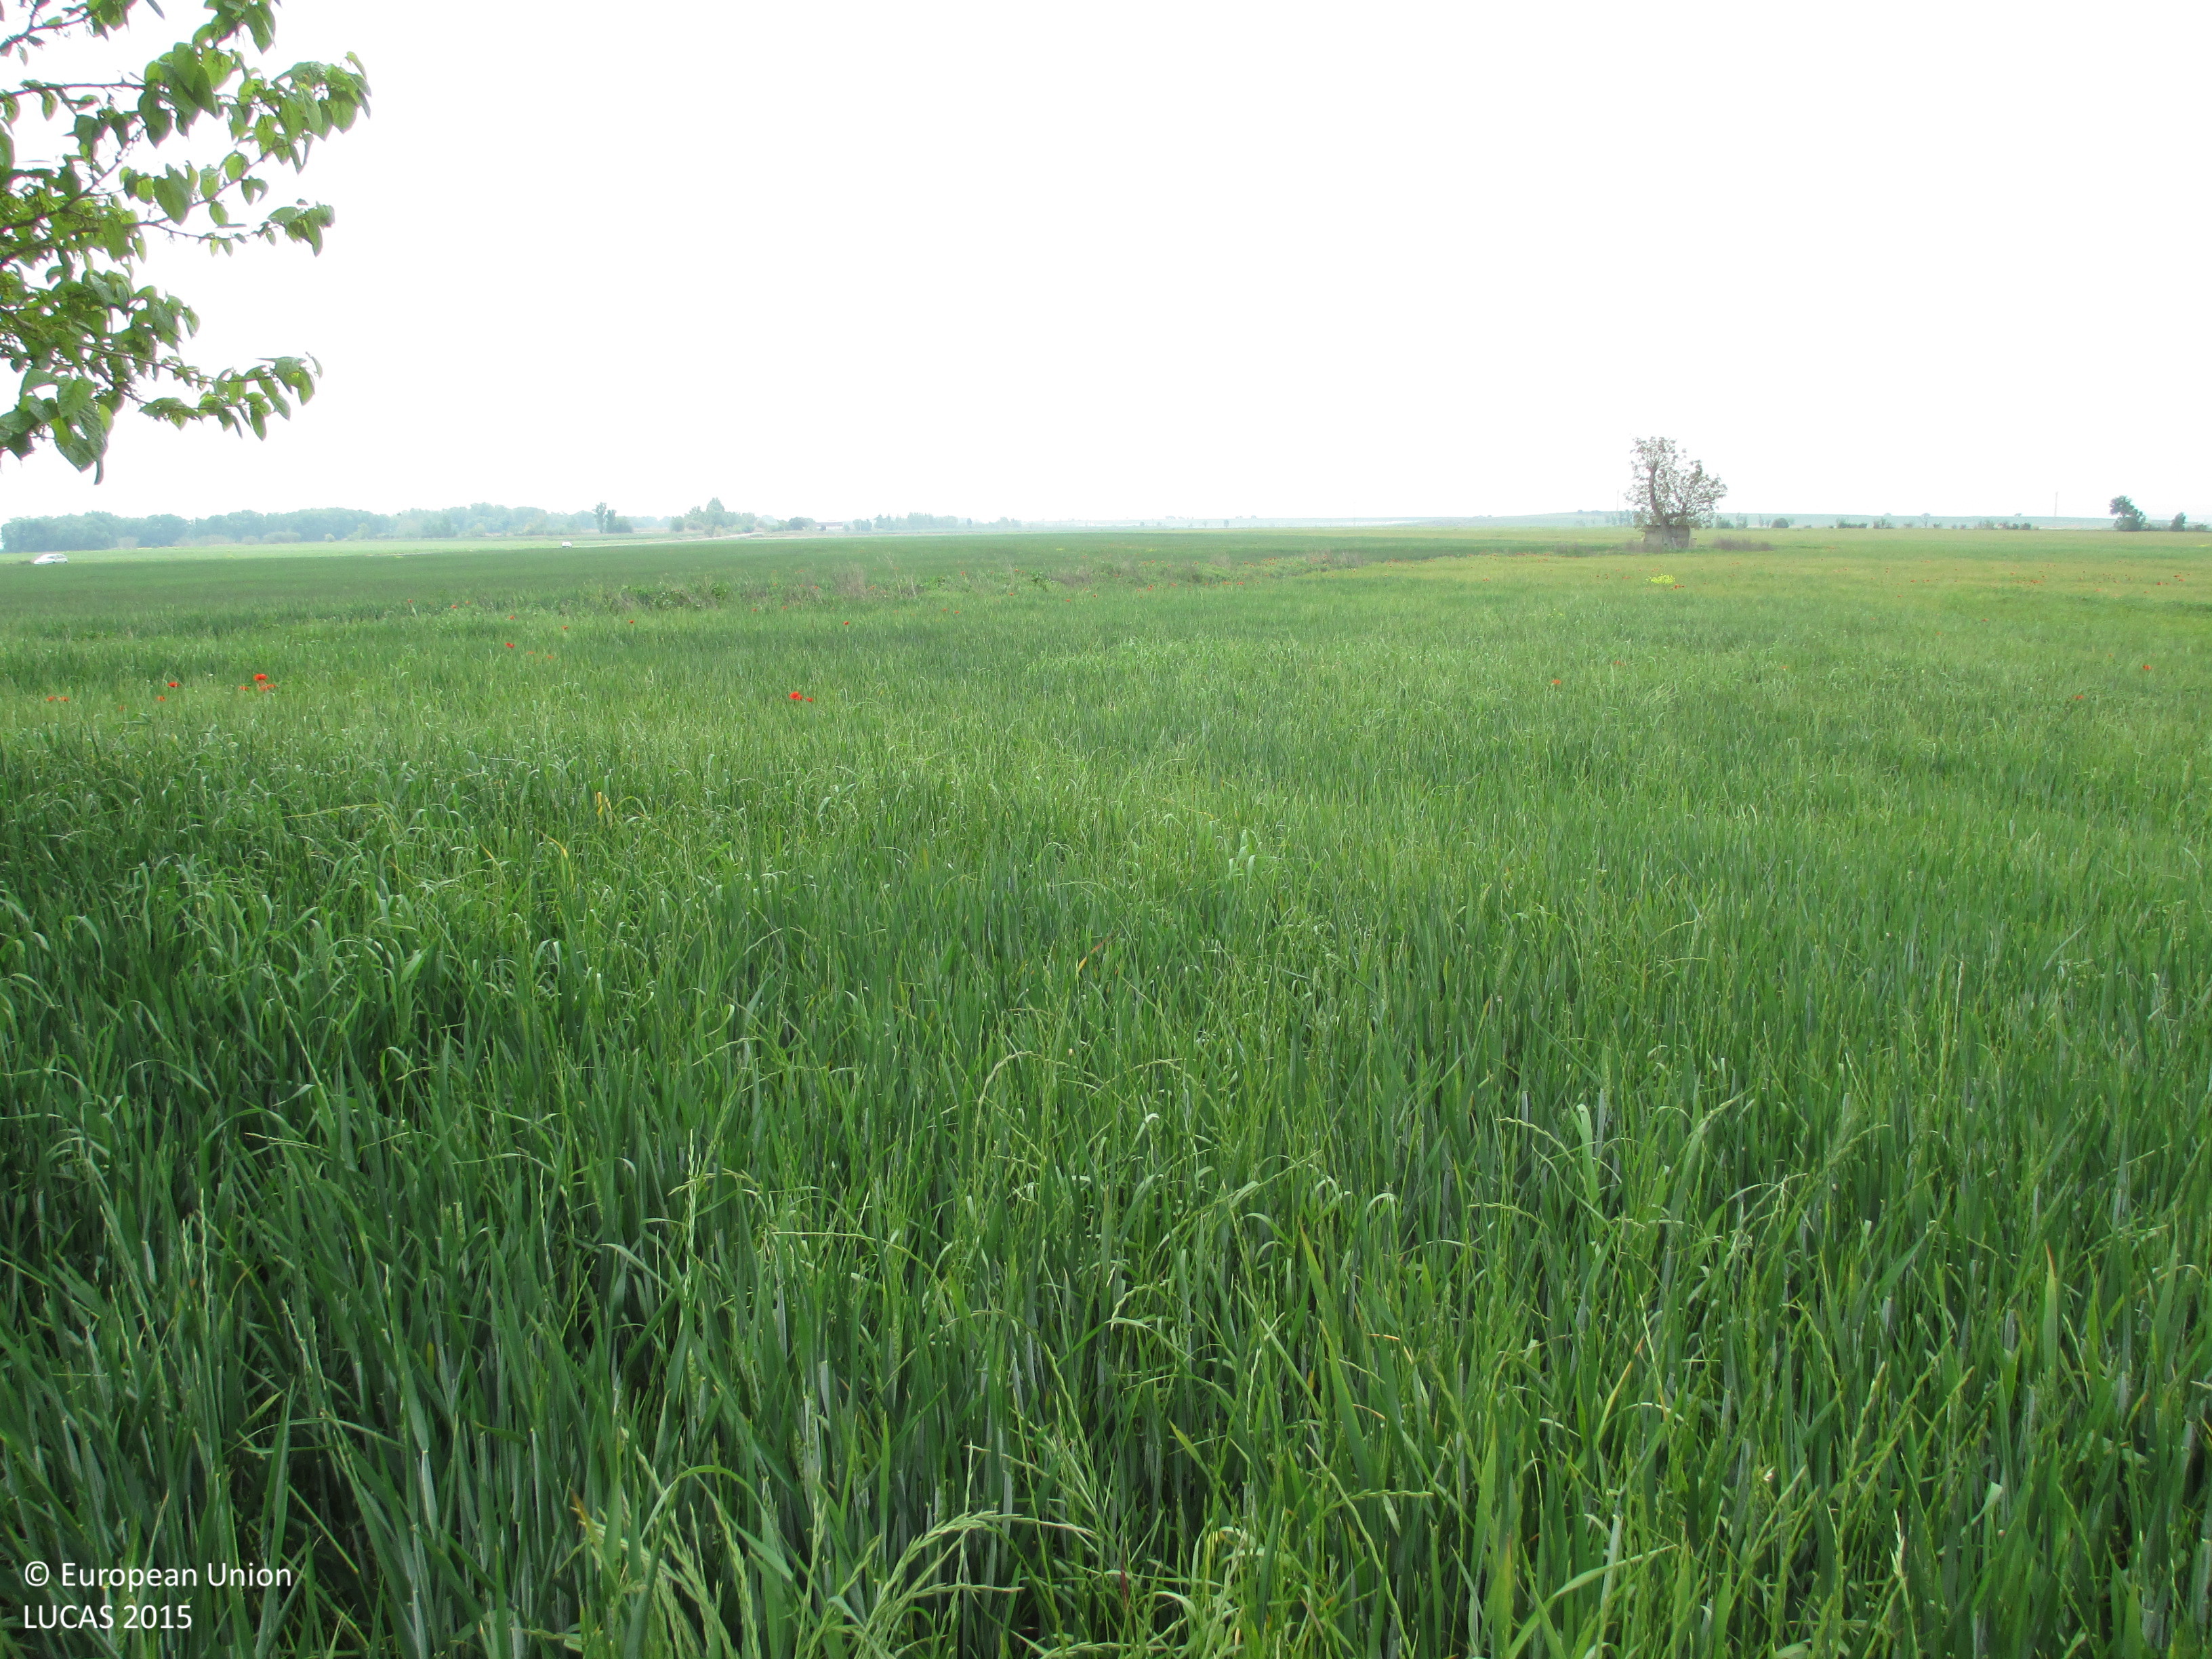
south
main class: Cropland
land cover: Durum wheat
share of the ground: > 75 %
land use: Agriculture (excluding fallow land and kitchen gardens)
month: April
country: ES
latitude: 42.0981
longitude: -0.4087
